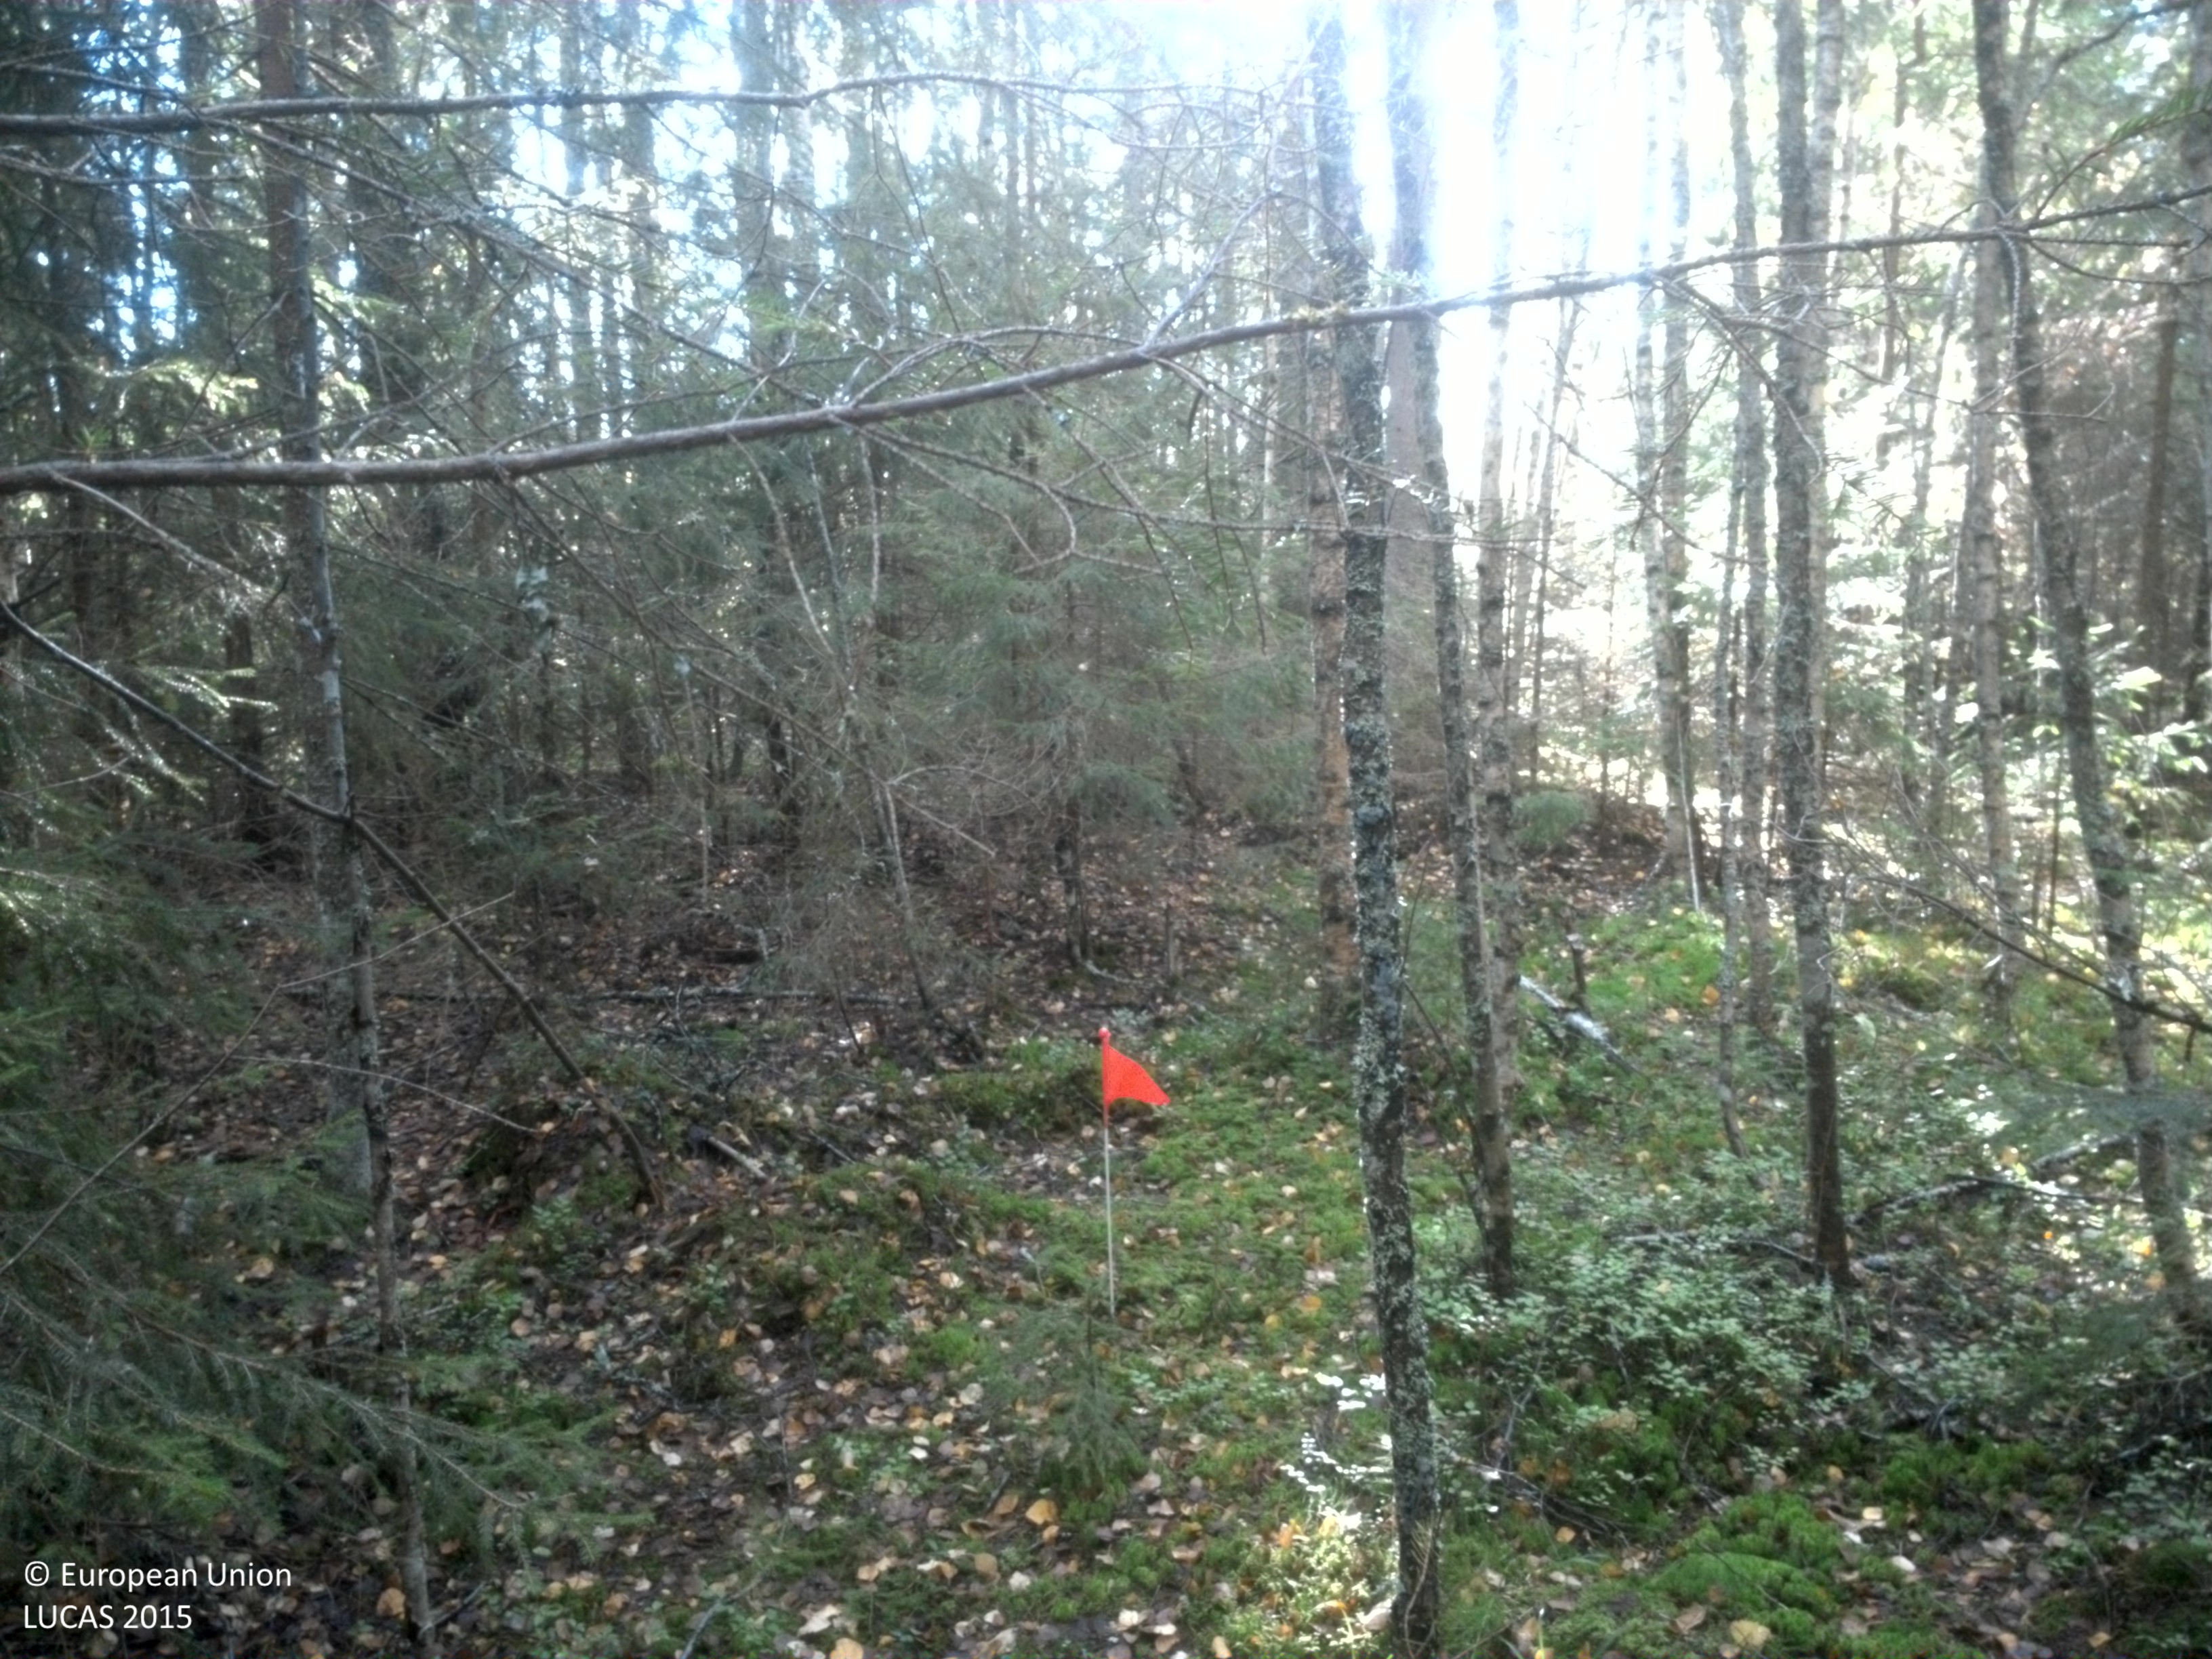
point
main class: Woodland
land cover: Spruce dominated mixed woodland
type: boreal forest
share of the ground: > 75 %
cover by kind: coniferous forest trees 55 %, broadleaved forest trees 25 %, lichens and mosses 15 %, shrubs 5 %
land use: Forestry
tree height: > 5 m
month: September
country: SE
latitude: 59.9090
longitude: 15.5508
